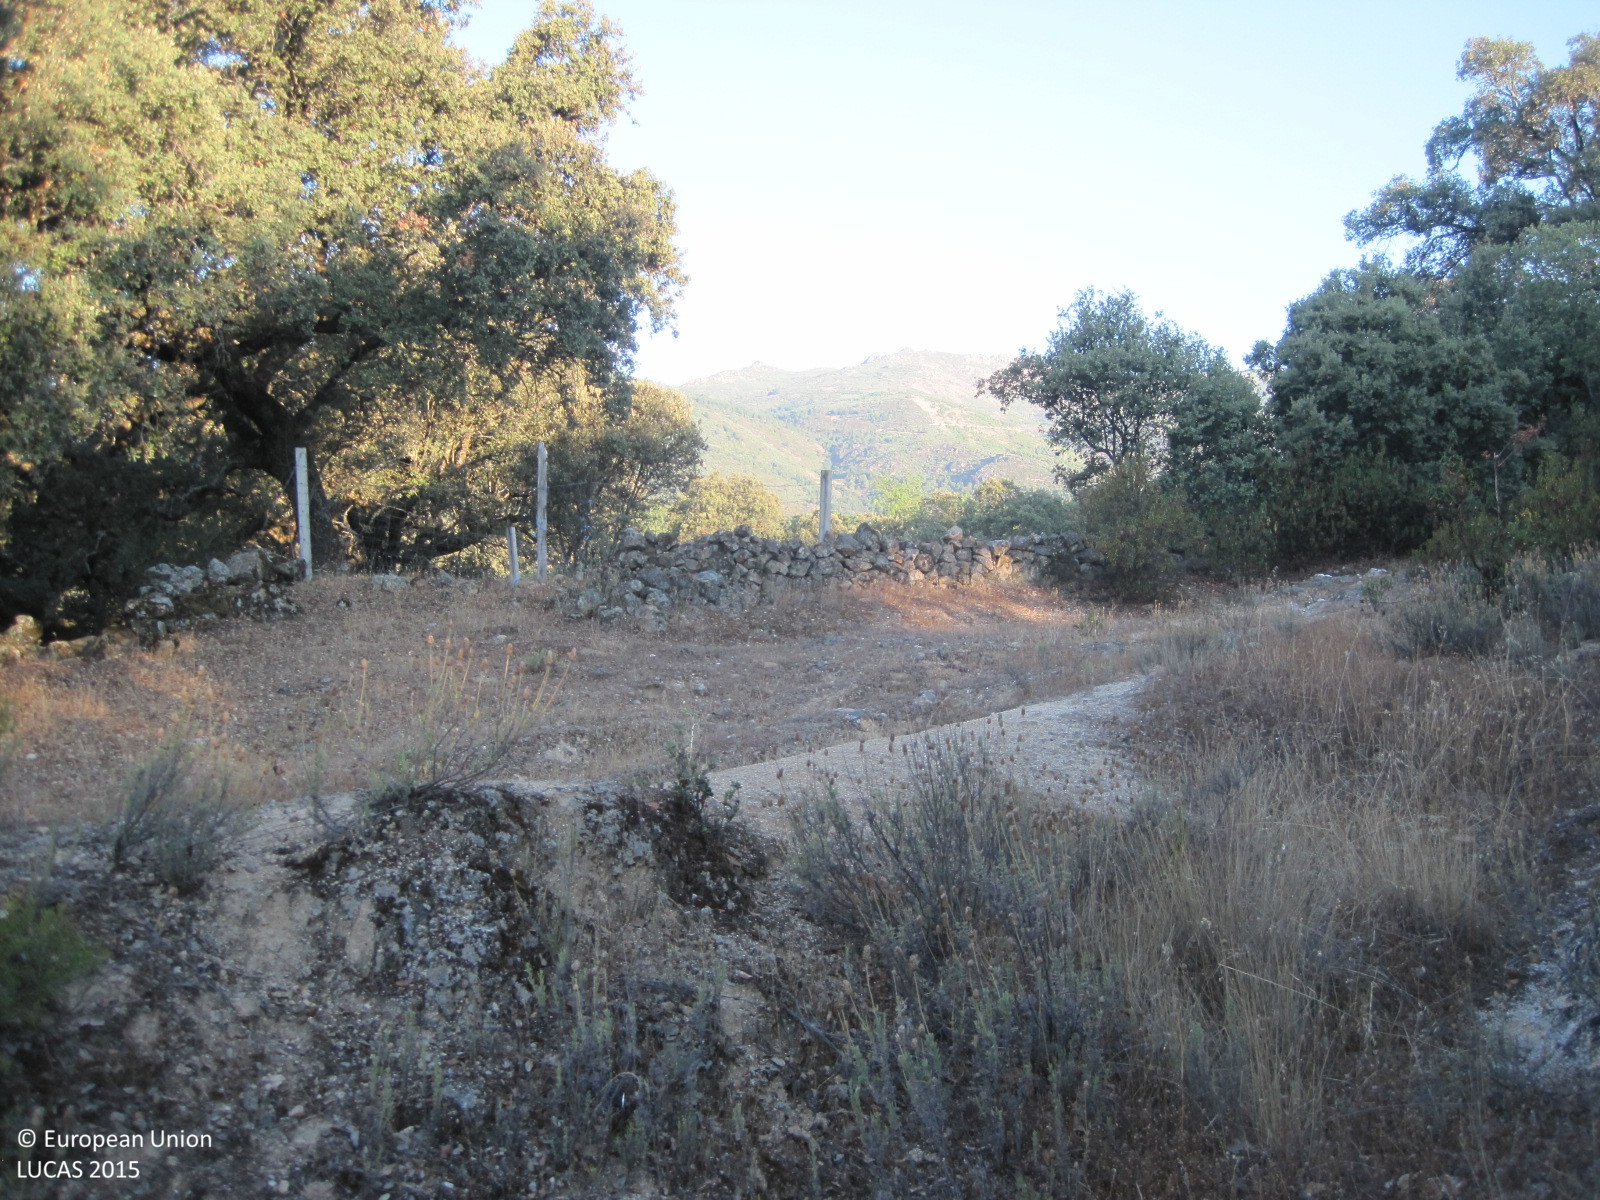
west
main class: Shrubland
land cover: Shrubland with sparse tree cover
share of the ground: > 75 %
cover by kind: shrubs 95 %, broadleaved forest trees 5 %
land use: Semi-natural and natural areas not in use
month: July
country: ES
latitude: 40.2495
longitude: -4.8534
